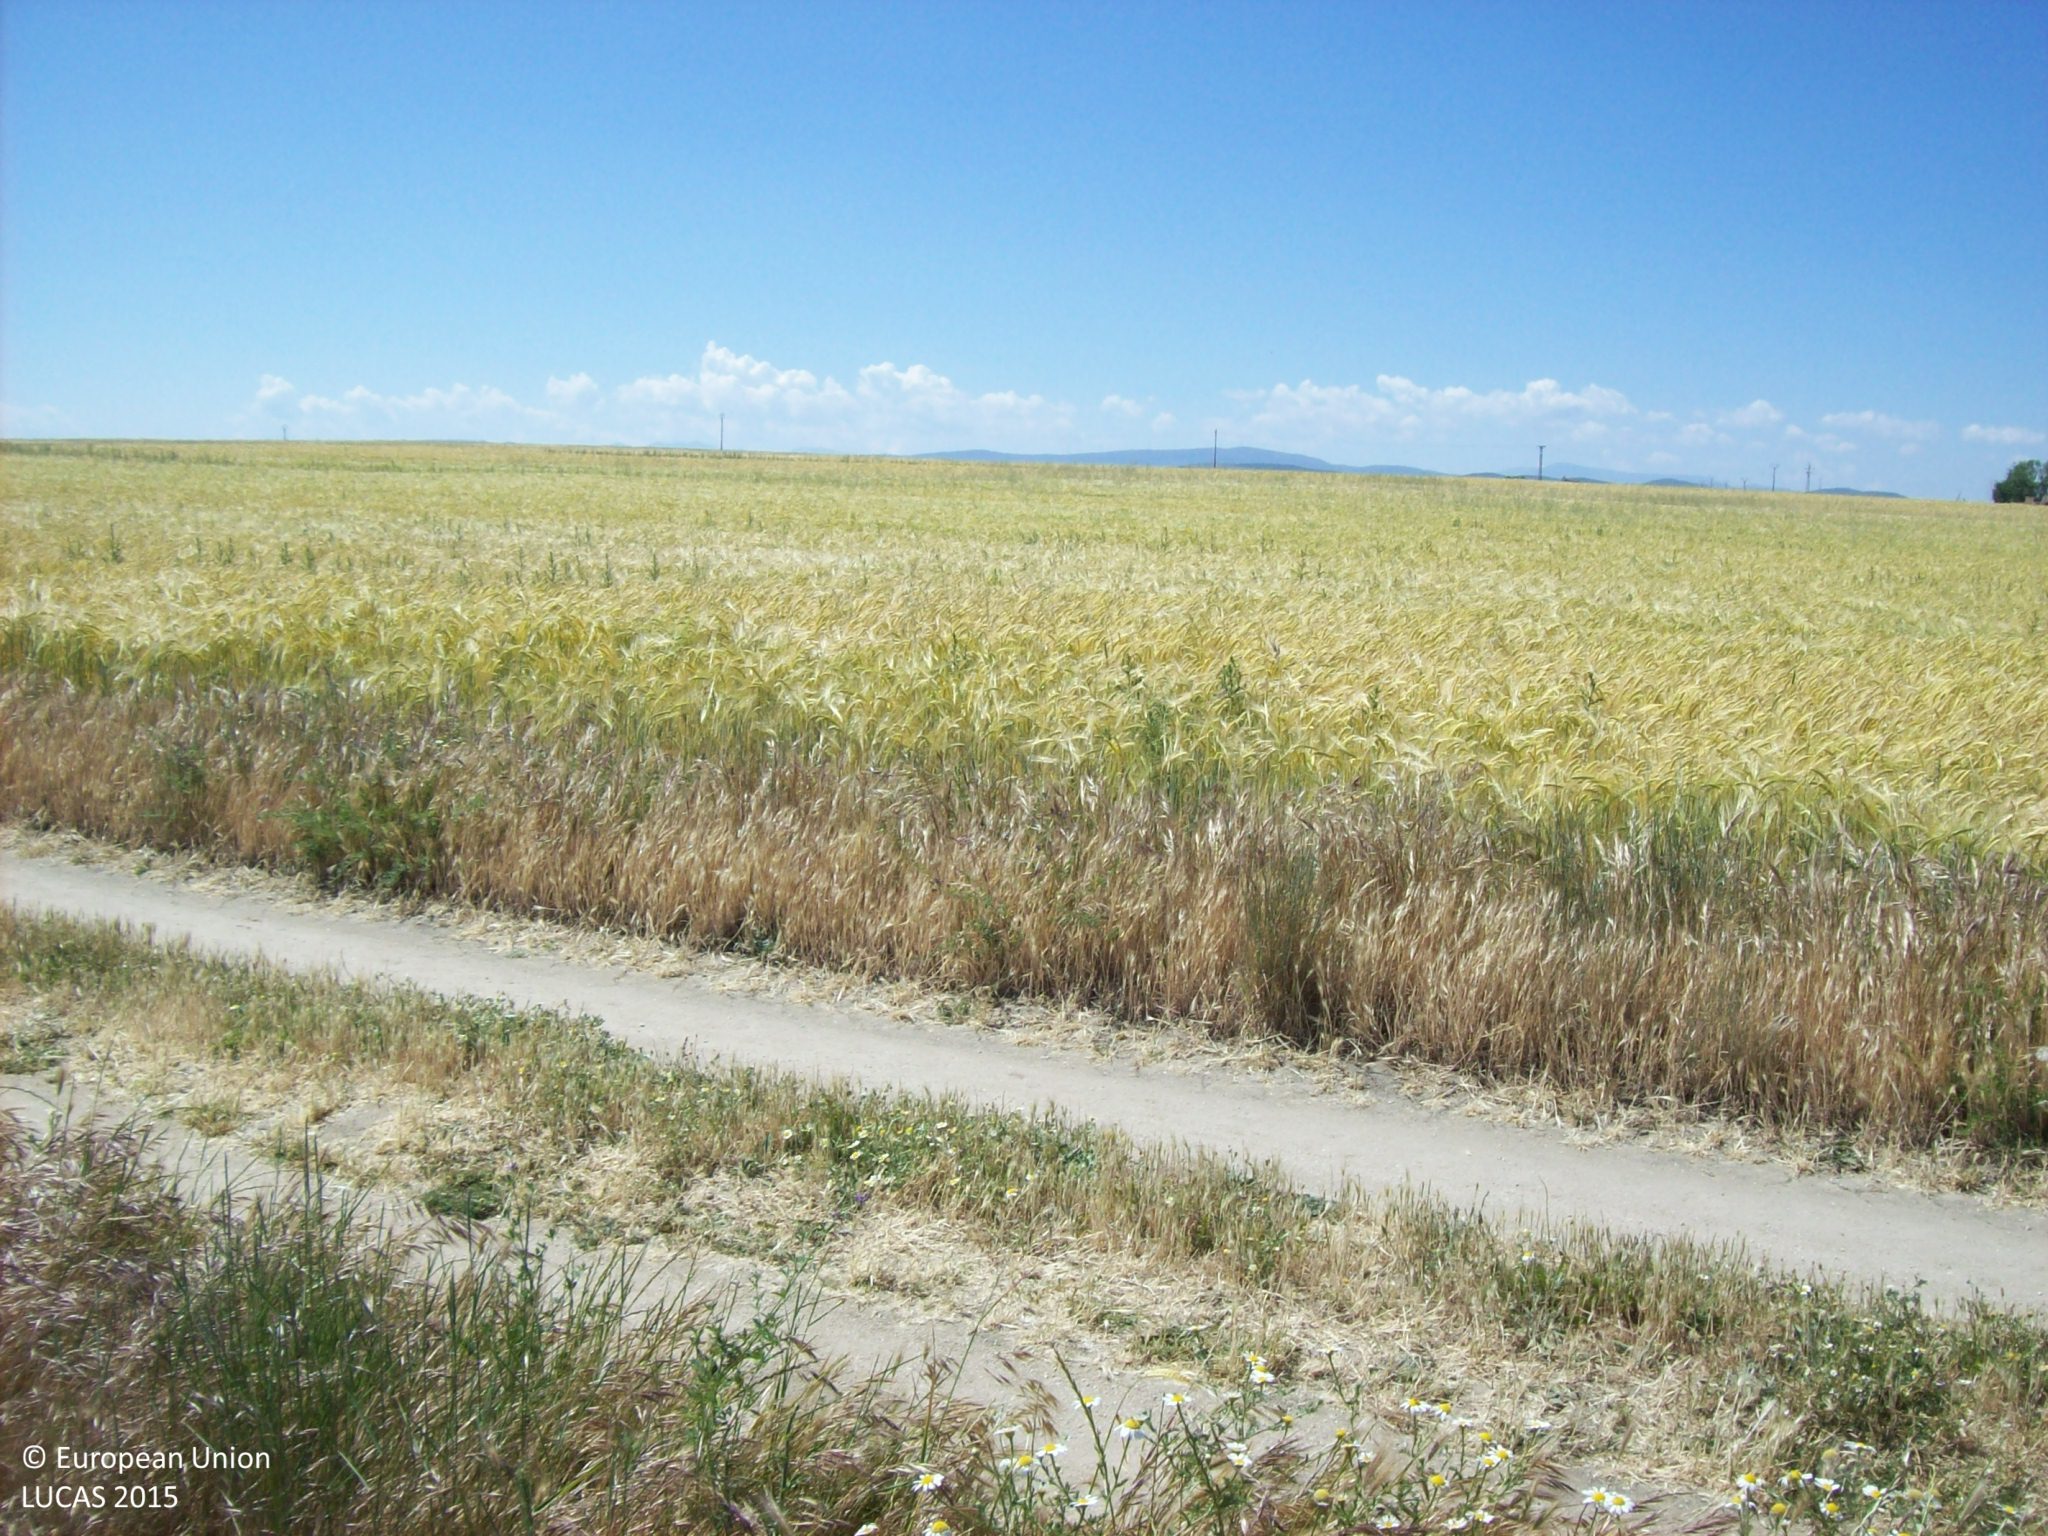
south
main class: Grassland
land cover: Spontaneously vegetated surfaces
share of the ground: 10 - 25 %
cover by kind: unconsolidated bare surface 60 %, herbaceous plants 15 %
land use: Fallow land
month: May
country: ES
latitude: 40.8939
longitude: -4.9594
